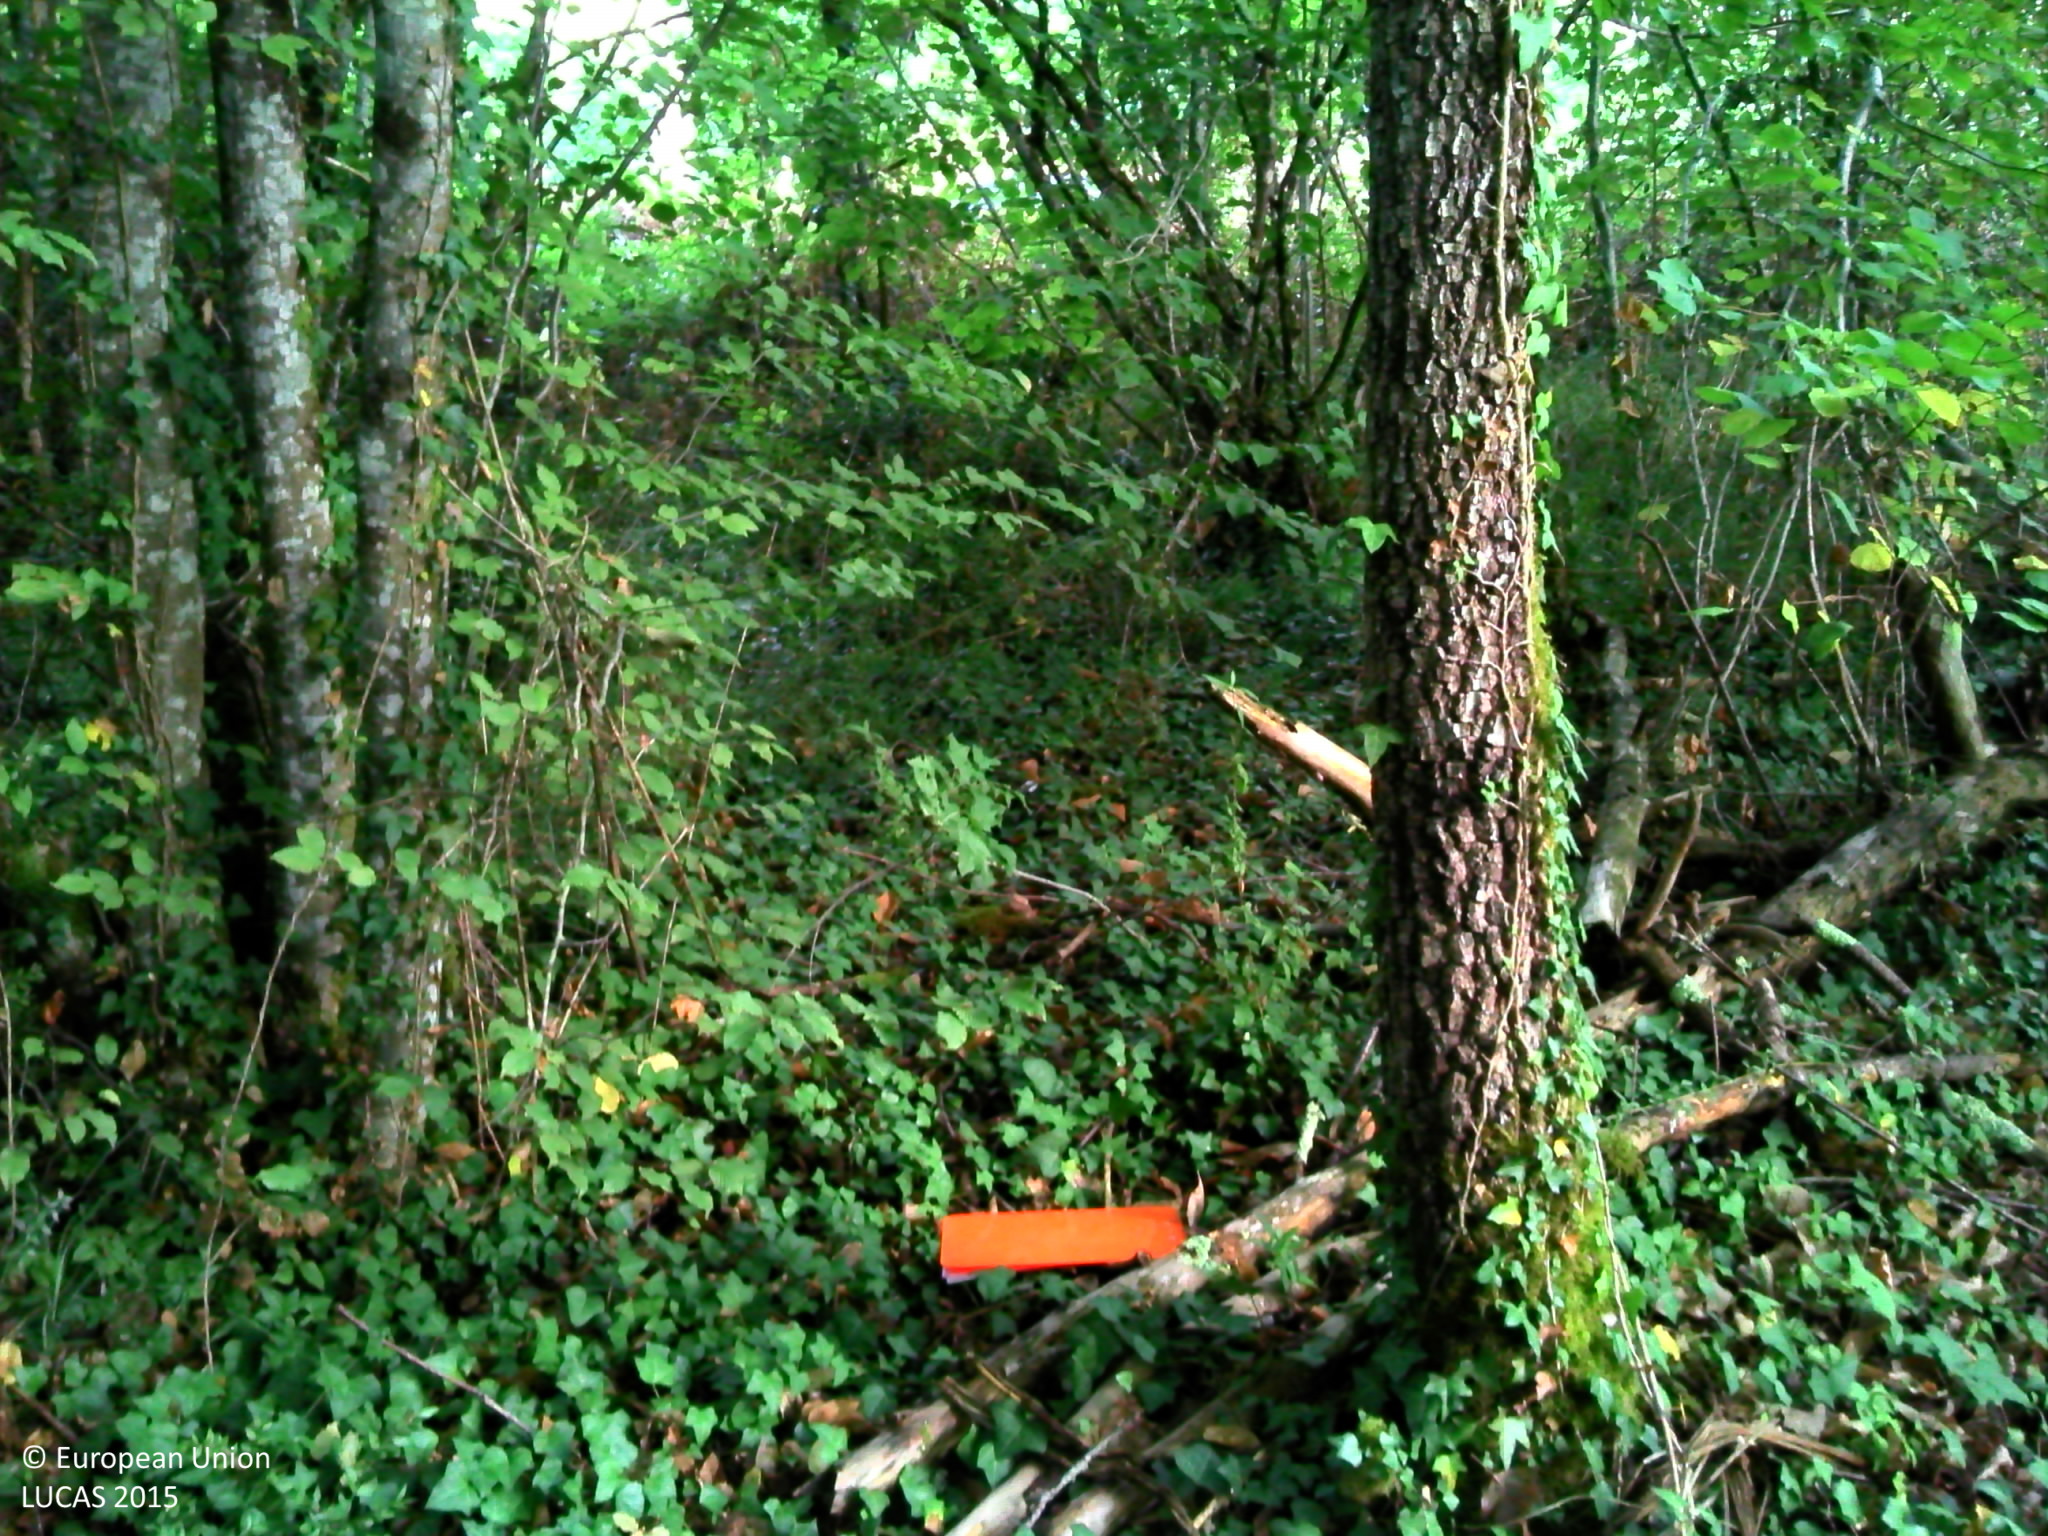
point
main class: Woodland
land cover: Broadleaved woodland
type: mesophytic deciduous forest
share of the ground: > 75 %
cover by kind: broadleaved forest trees 80 %, herbaceous plants 10 %, shrubs 5 %, lichens and mosses 5 %
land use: Forestry
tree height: > 5 m
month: July
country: FR
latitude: 44.8601
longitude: 1.1486
